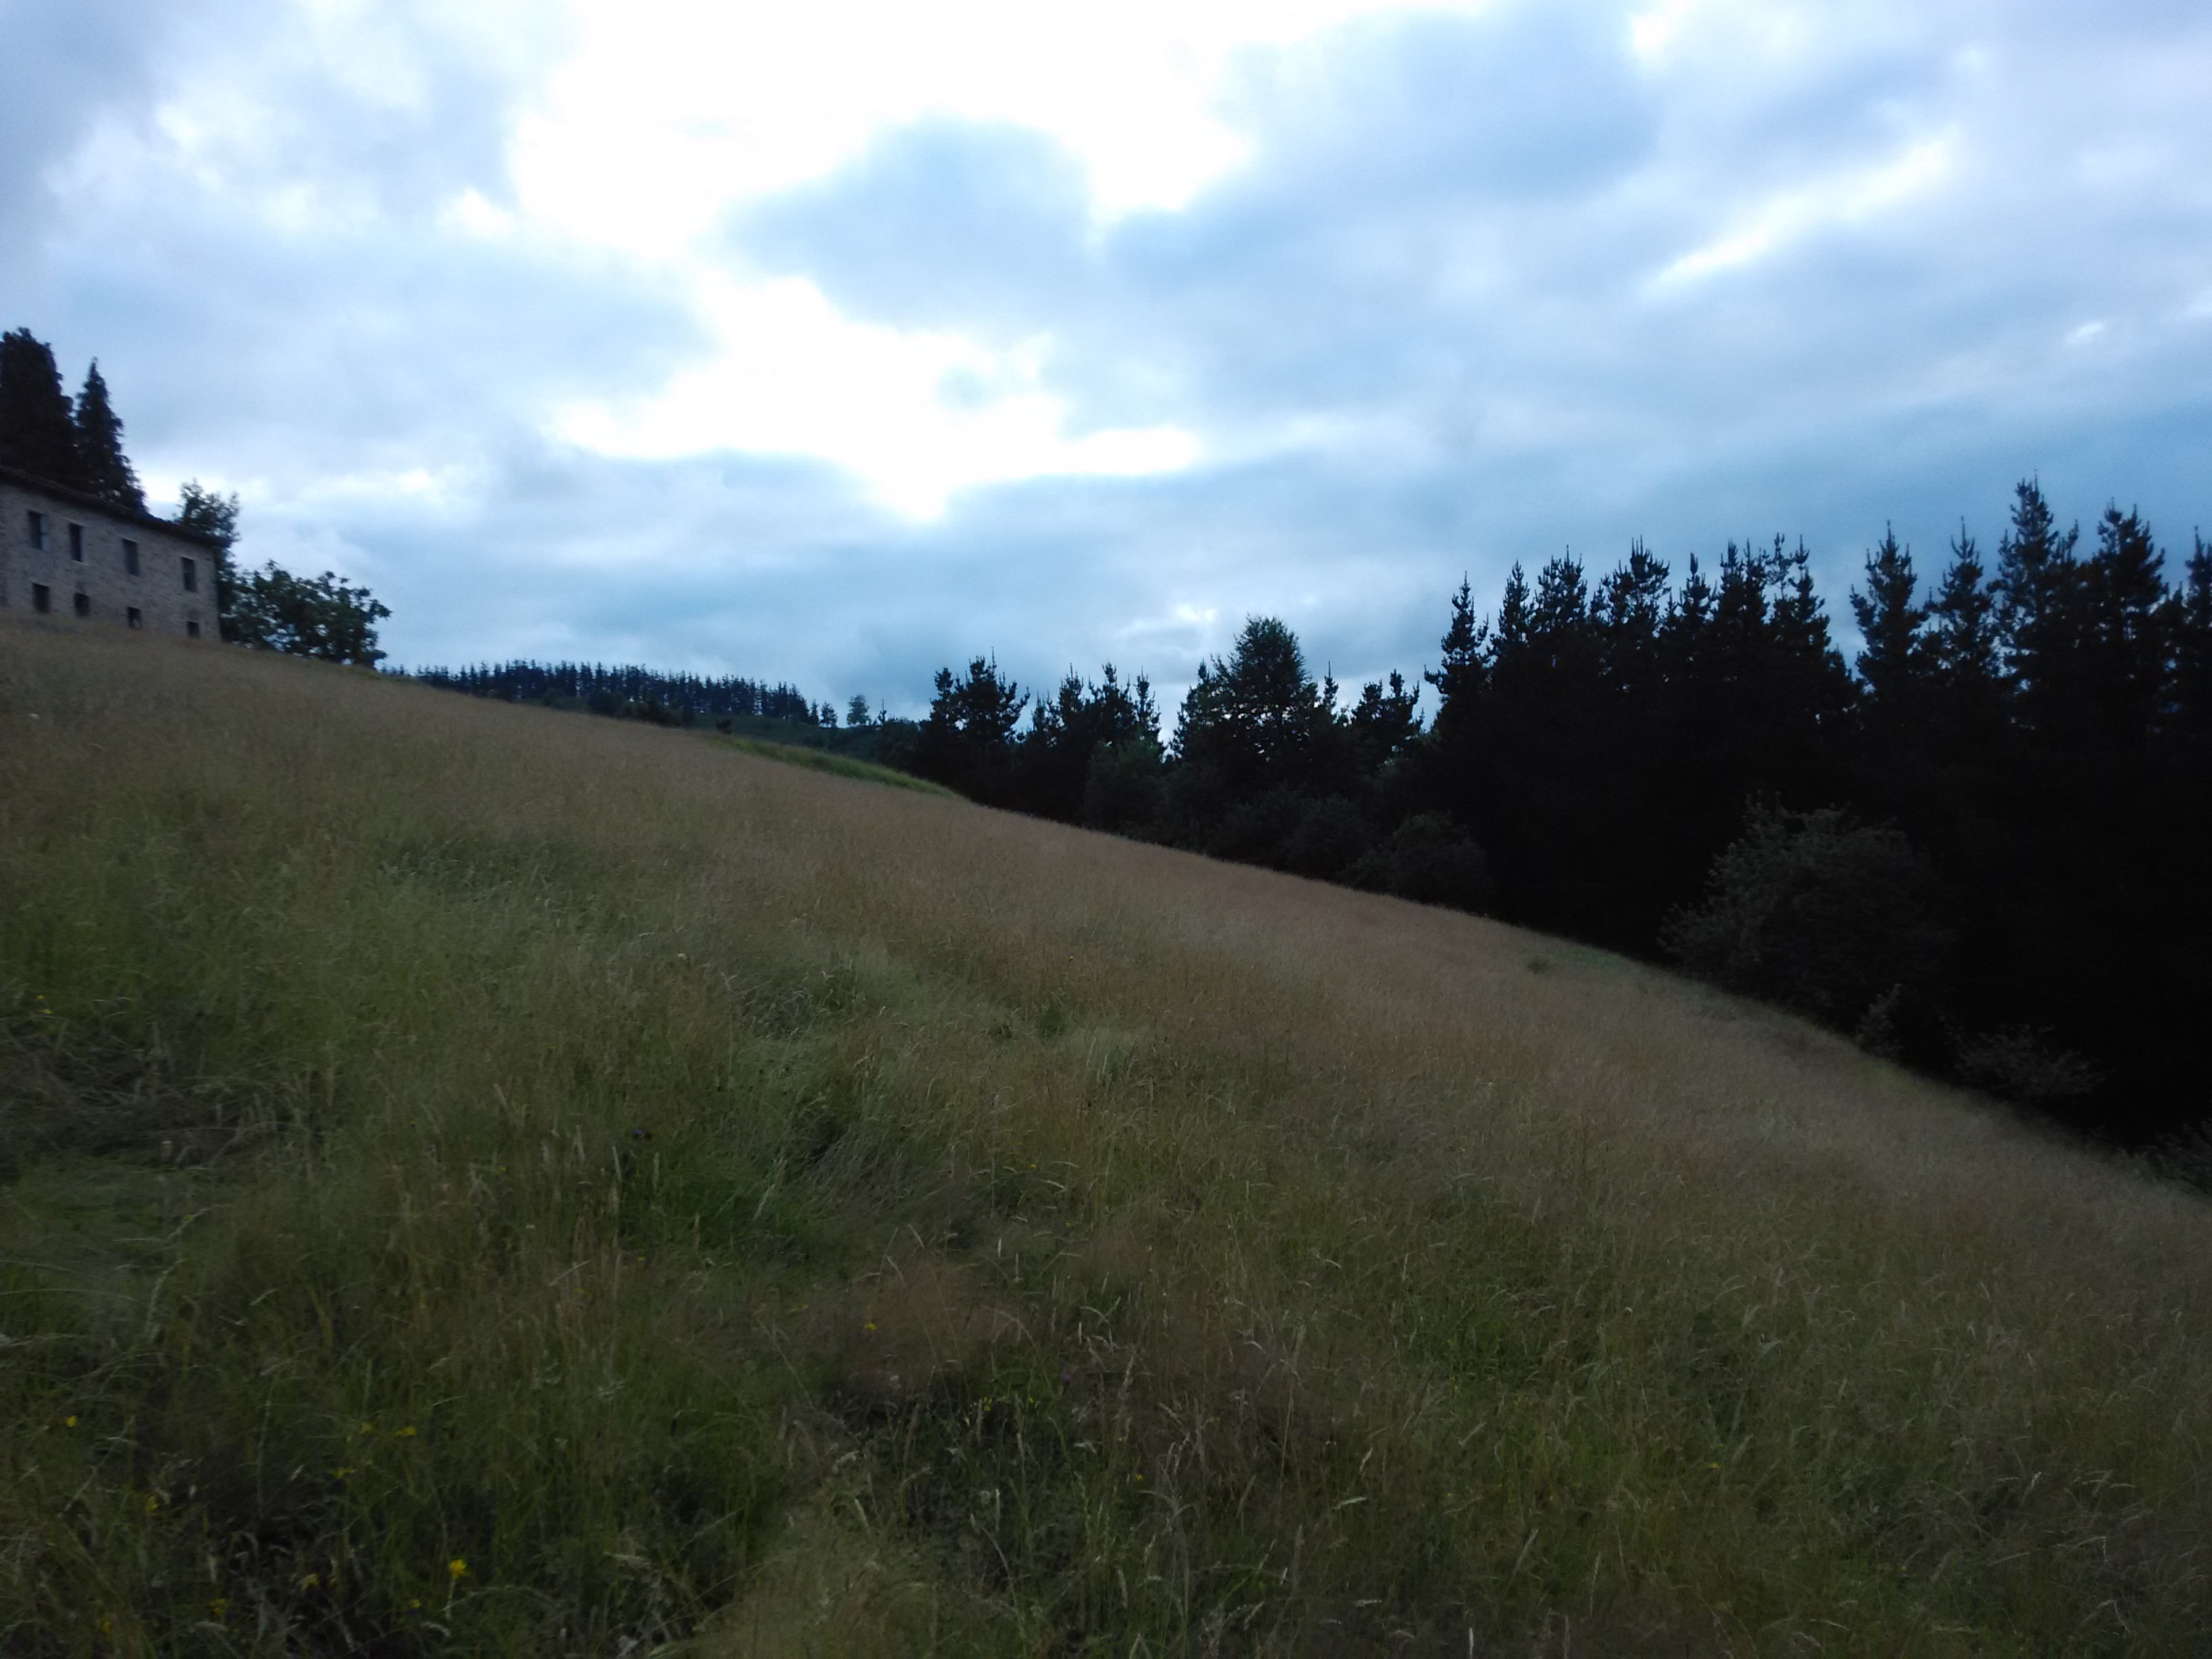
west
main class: Grassland
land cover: Grassland without tree/shrub cover
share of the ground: > 75 %
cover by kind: herbaceous plants 100 %
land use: Agriculture (excluding fallow land and kitchen gardens)
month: July
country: ES
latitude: 43.1645
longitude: -2.4121
